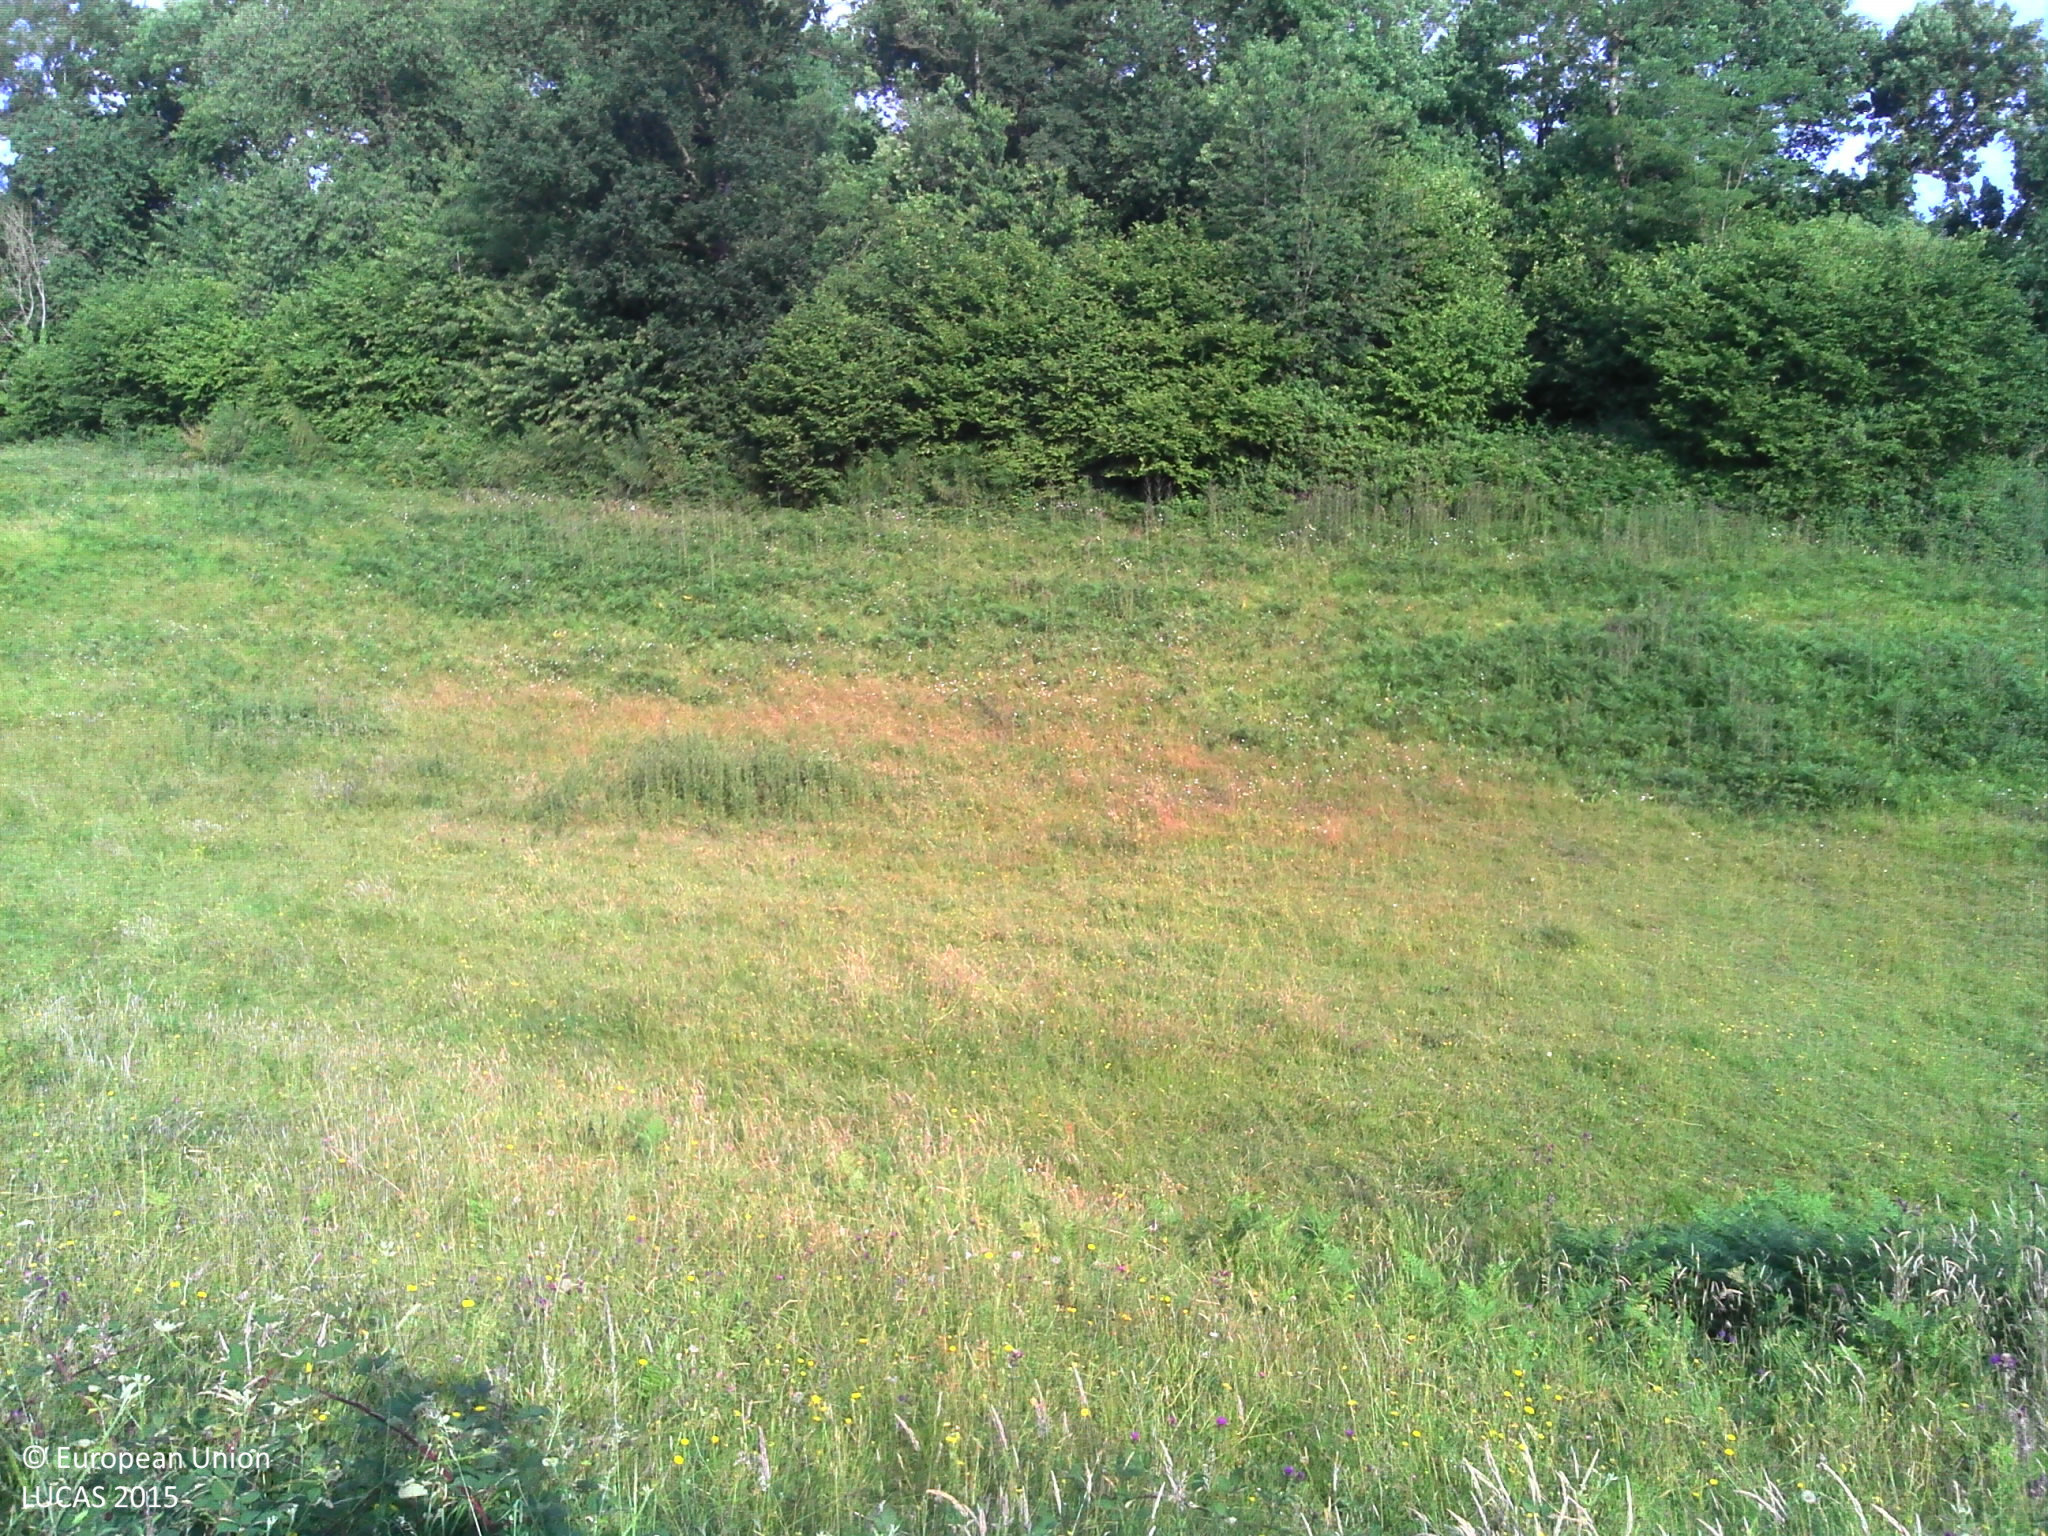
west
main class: Grassland
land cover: Grassland without tree/shrub cover
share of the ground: > 75 %
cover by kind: herbaceous plants 100 %
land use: Agriculture (excluding fallow land and kitchen gardens)
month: July
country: FR
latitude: 48.9903
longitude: 0.0895
